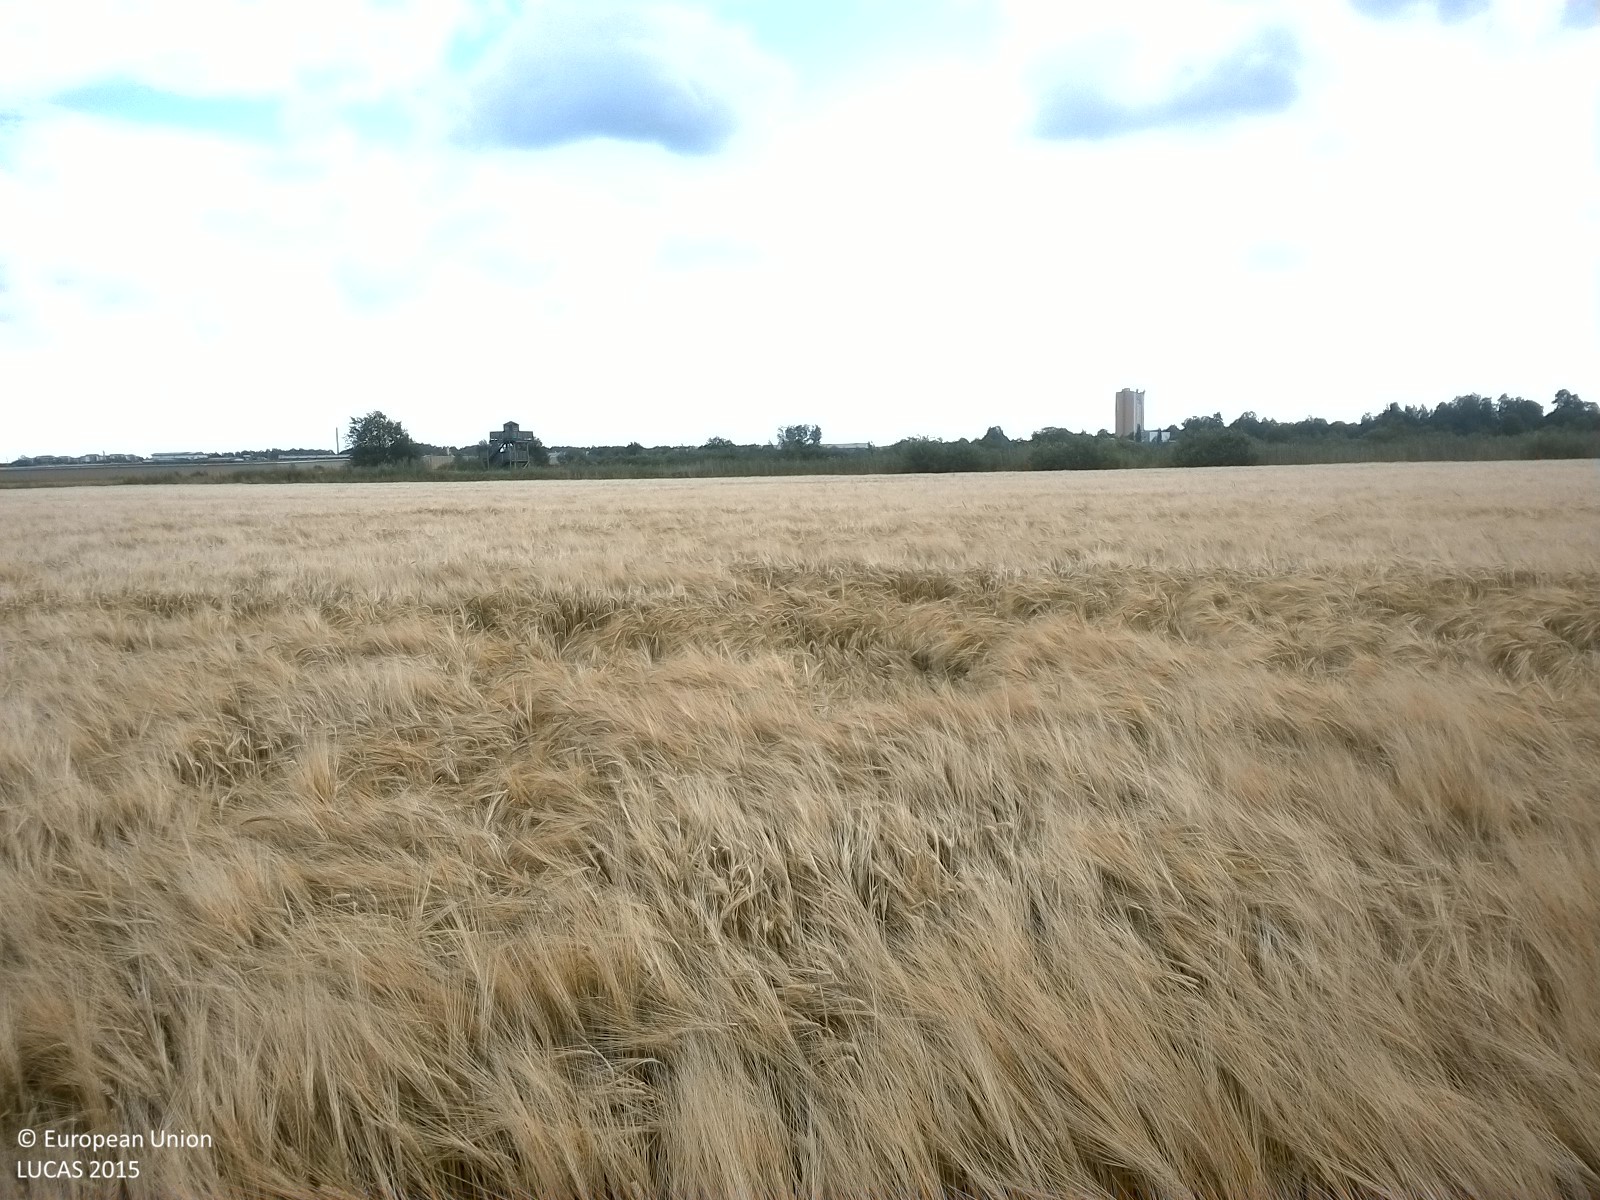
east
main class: Cropland
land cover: Barley
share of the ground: > 75 %
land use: Agriculture (excluding fallow land and kitchen gardens)
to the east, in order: Barley; Ditches and canals; Abandoned hedges; Grass margins; Inland marshes; Broadleaved woodland; Inland marshes
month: August
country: SE
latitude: 59.1141
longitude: 15.1094
